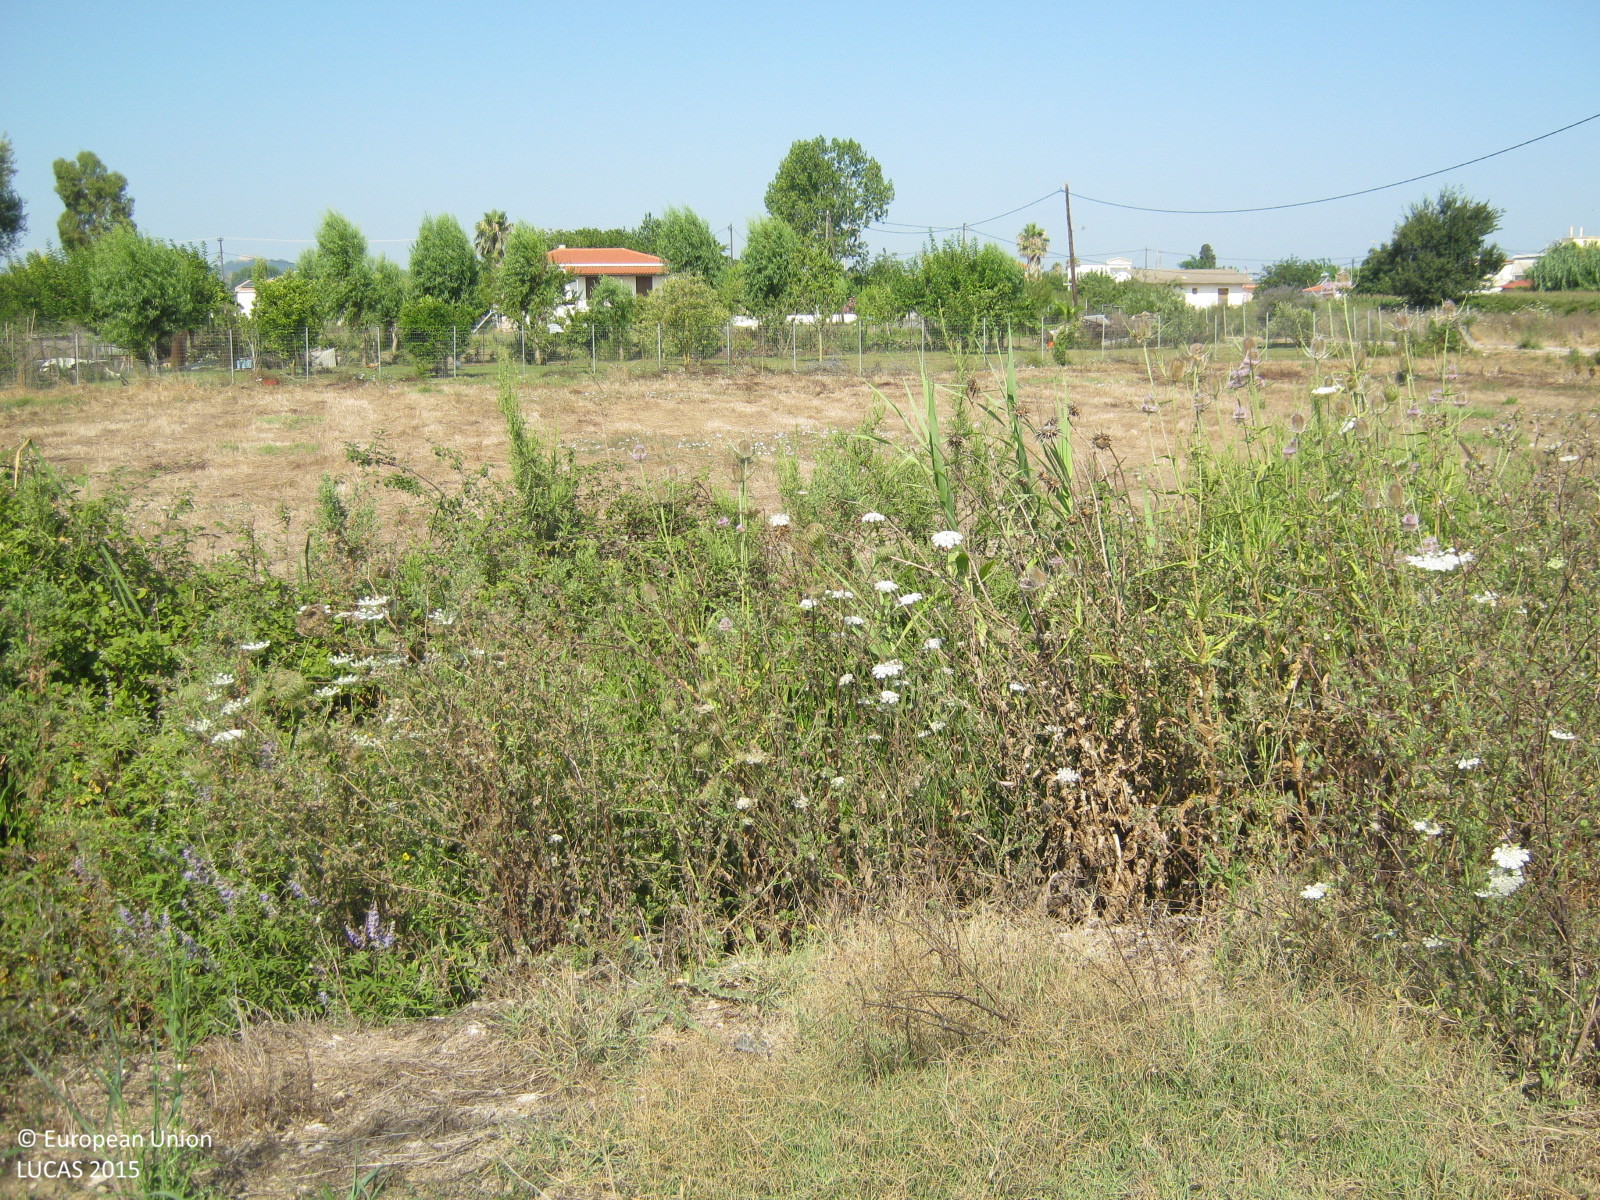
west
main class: Cropland
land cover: Maize
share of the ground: > 75 %
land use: Agriculture (excluding fallow land and kitchen gardens)
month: July
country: GR
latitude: 37.9057
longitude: 21.2087
